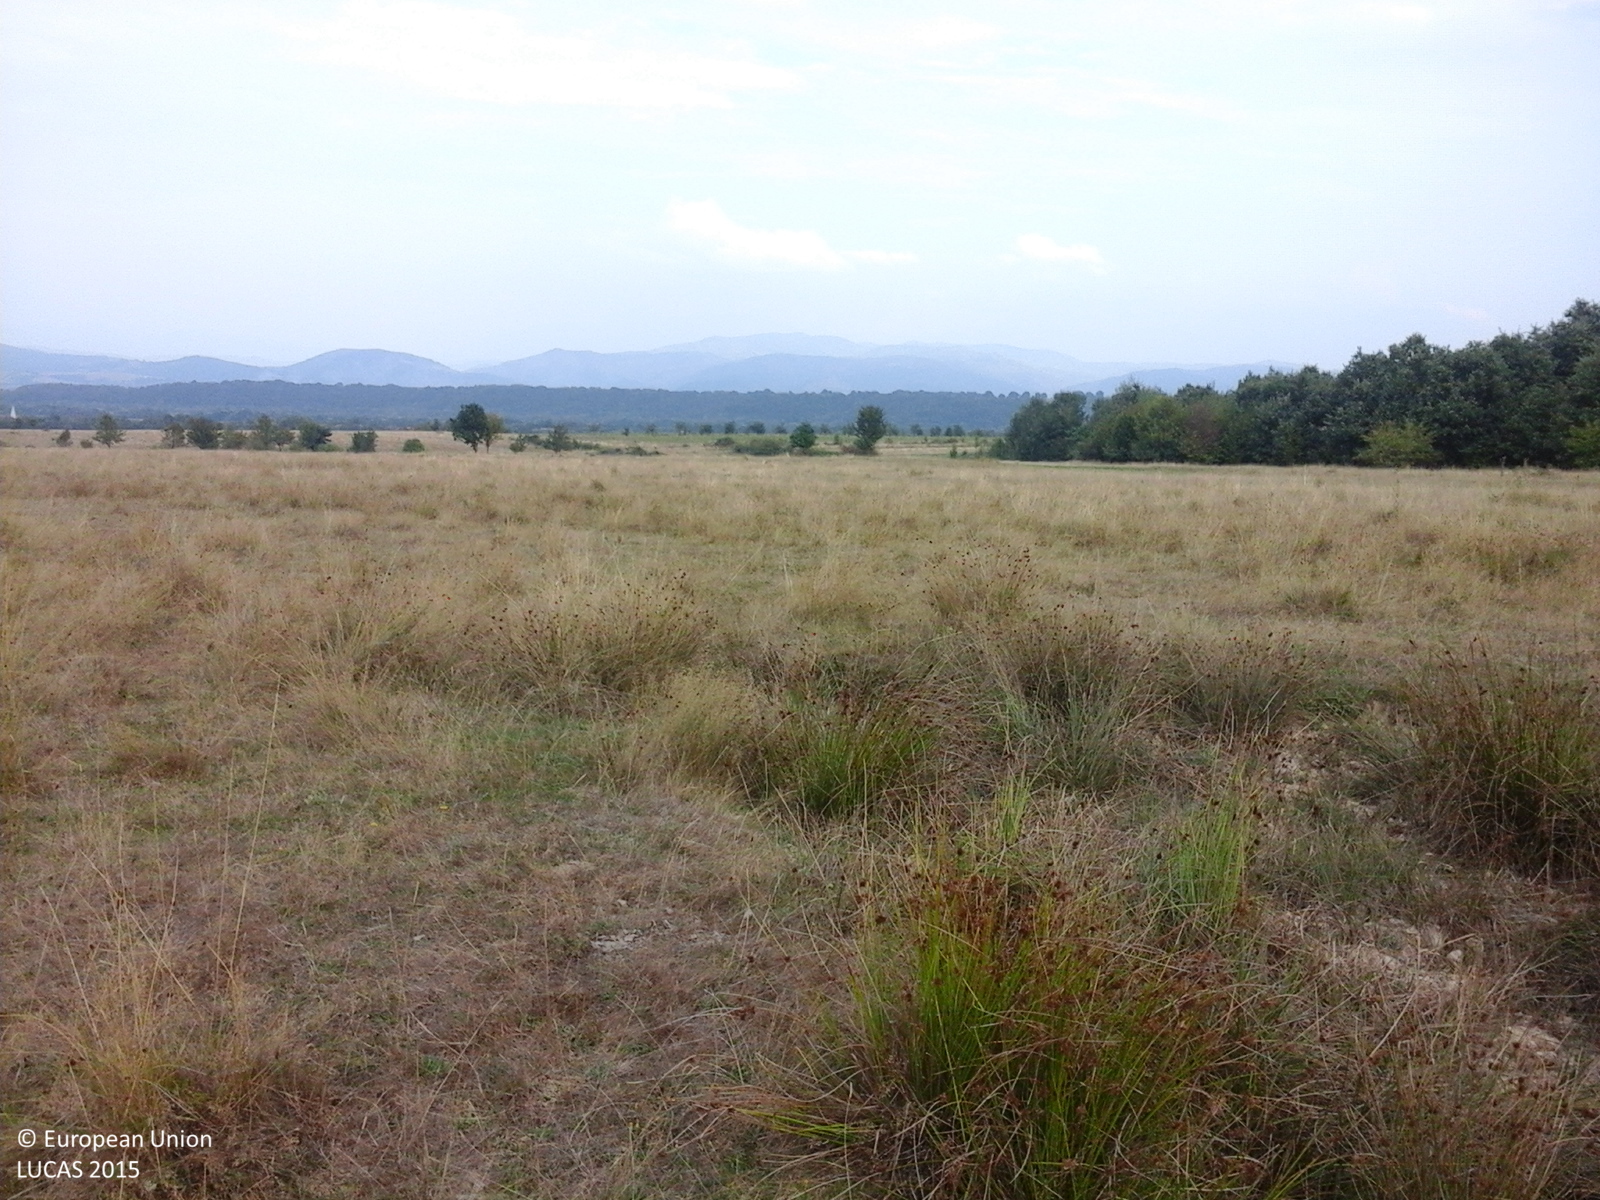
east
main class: Grassland
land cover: Grassland without tree/shrub cover
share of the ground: > 75 %
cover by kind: herbaceous plants 100 %
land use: Agriculture (excluding fallow land and kitchen gardens)
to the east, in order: Grassland without tree/shrub cover; Grassland with sparse tree/shrub cover
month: August
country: RO
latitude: 46.2655
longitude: 22.2294
